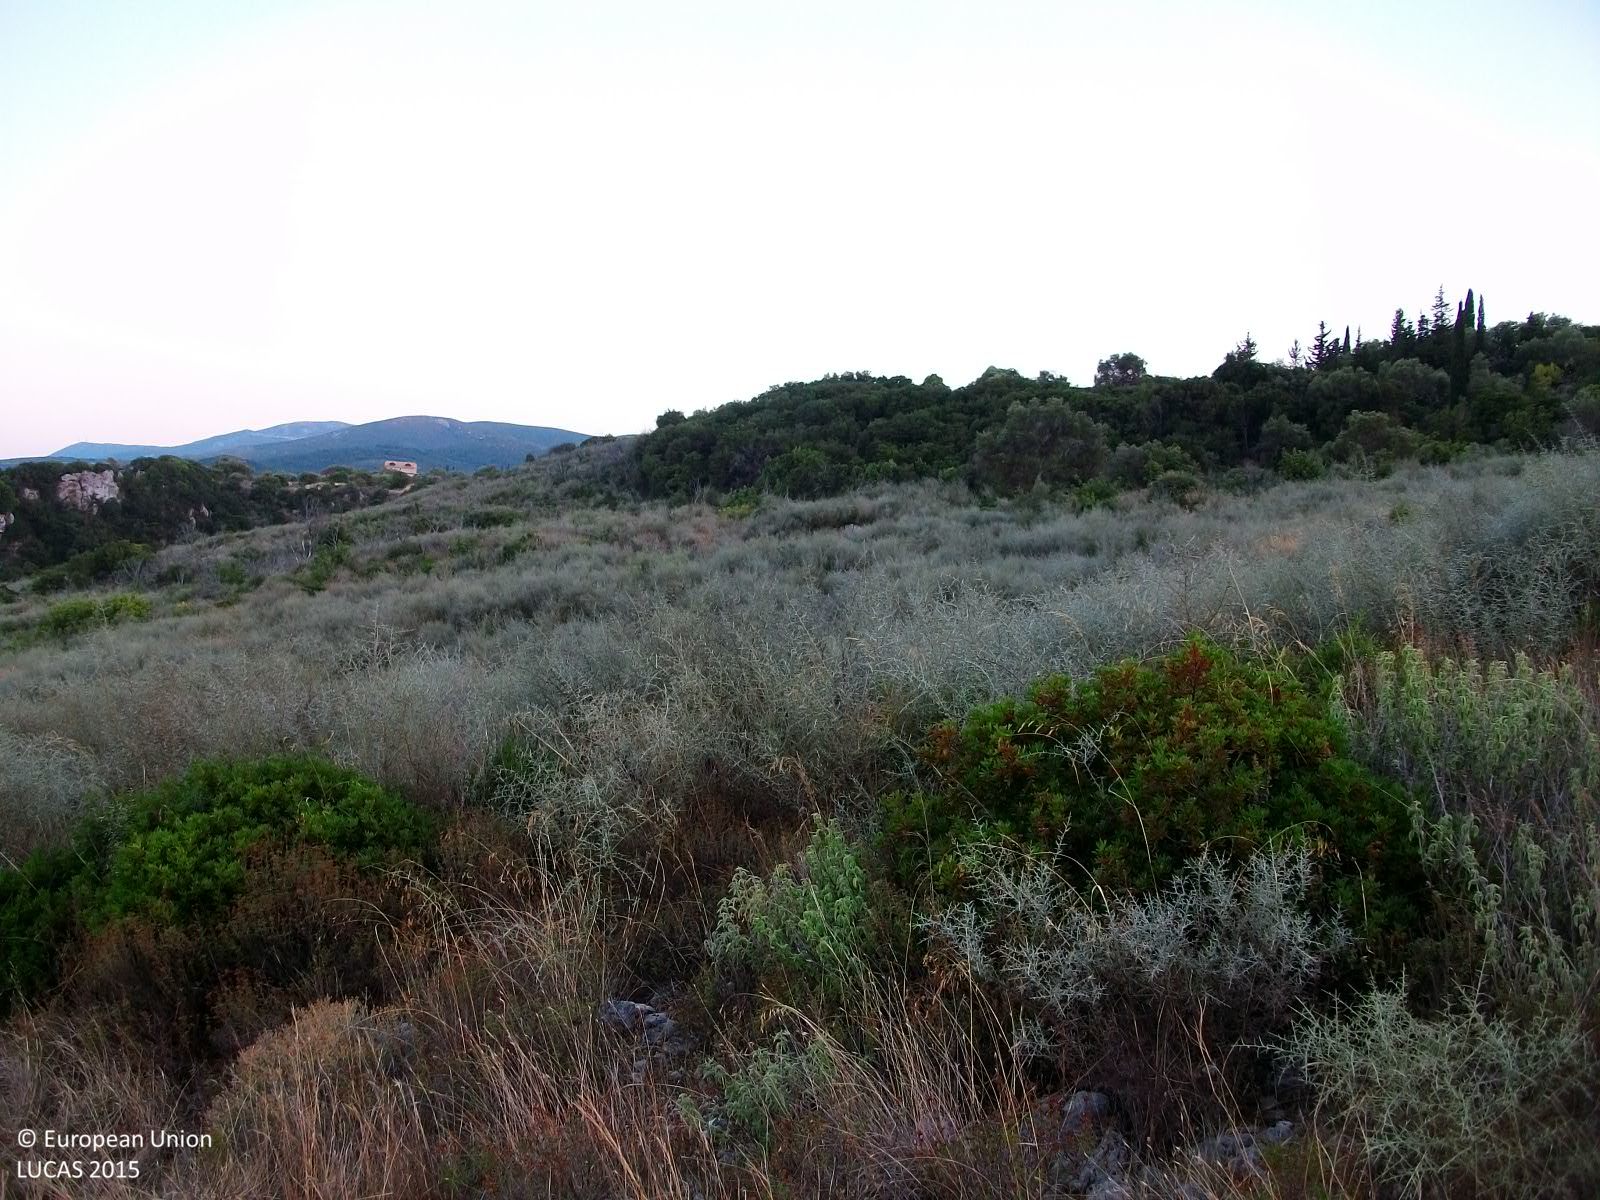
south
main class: Shrubland
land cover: Shrubland with sparse tree cover
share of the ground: > 75 %
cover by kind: shrubs 95 %, broadleaved forest trees 5 %
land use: Semi-natural and natural areas not in use
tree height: < 5 m
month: August
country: GR
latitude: 37.8910
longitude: 20.7040
